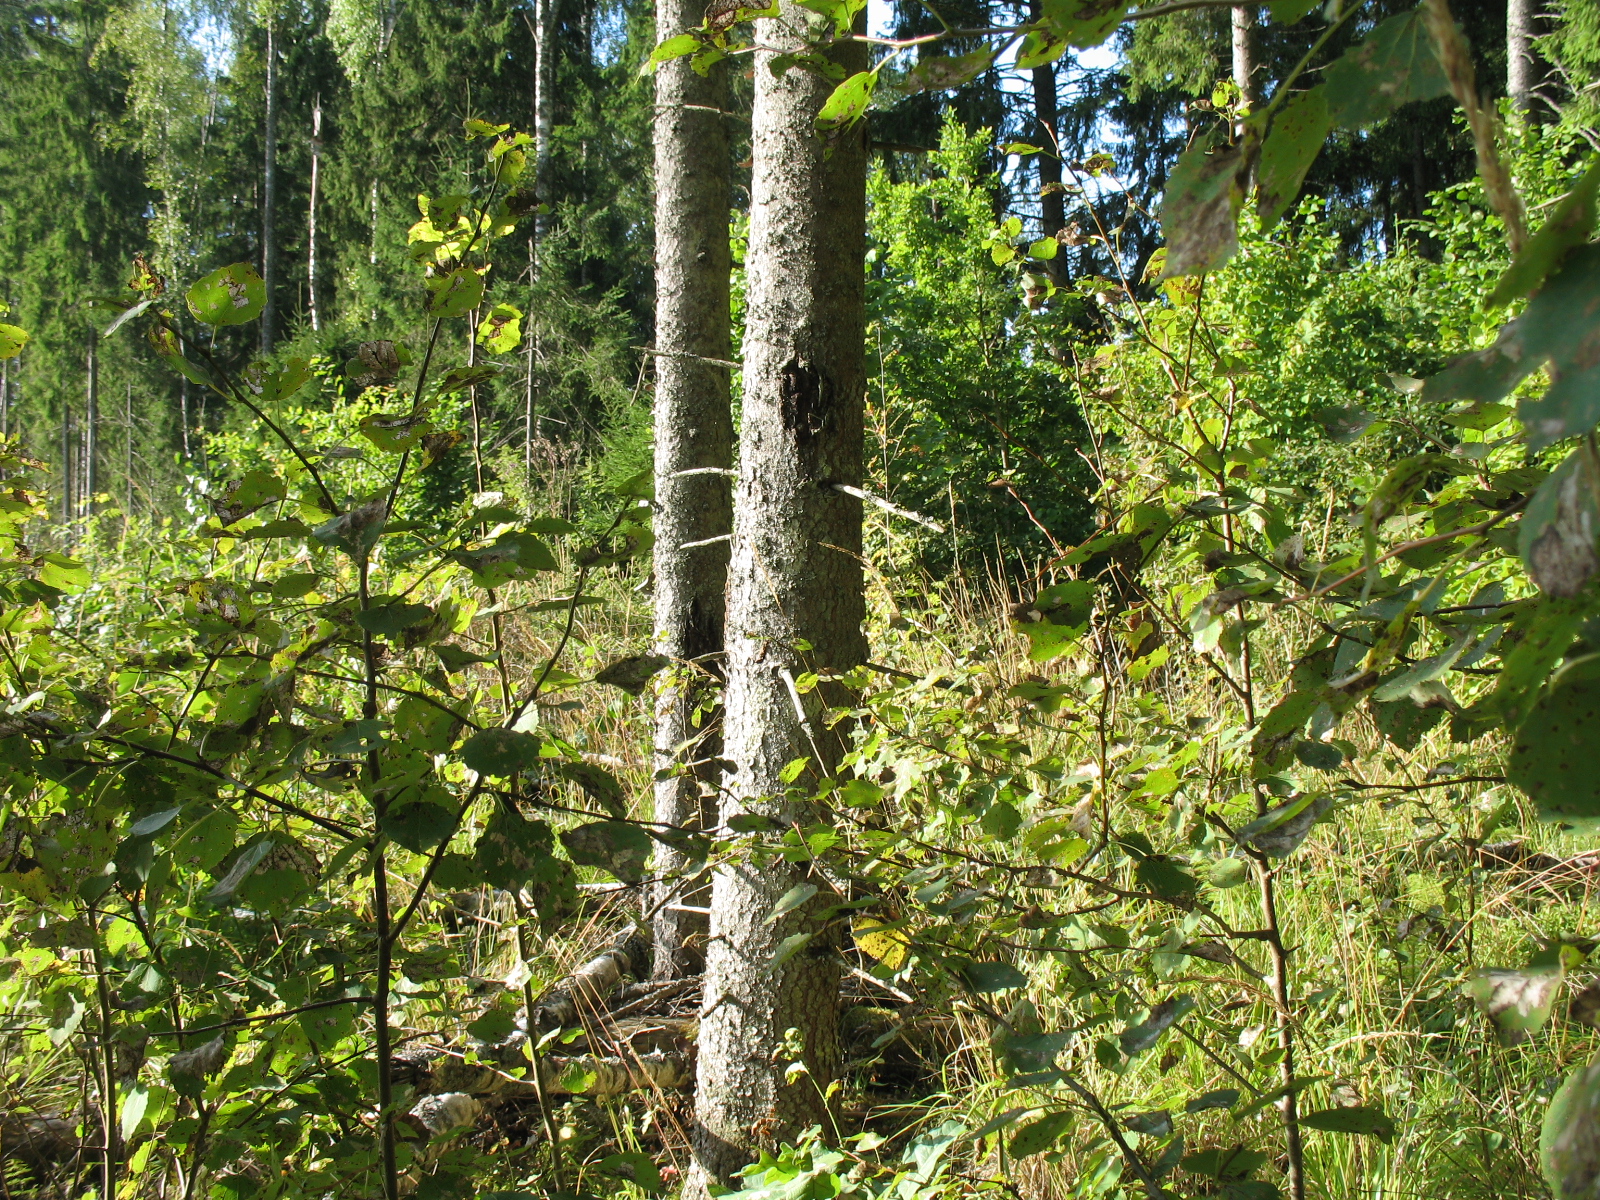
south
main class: Woodland
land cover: Spruce dominated mixed woodland
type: hemiboreal forest and nemoral coniferous forest and mixed broadleaved-coniferous forest
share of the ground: 50 - 75 %
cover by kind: coniferous forest trees 40 %, broadleaved forest trees 30 %, shrubs 20 %, herbaceous plants 10 %
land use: Forestry
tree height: > 5 m
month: August
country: LV
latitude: 56.3666
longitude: 26.0155
